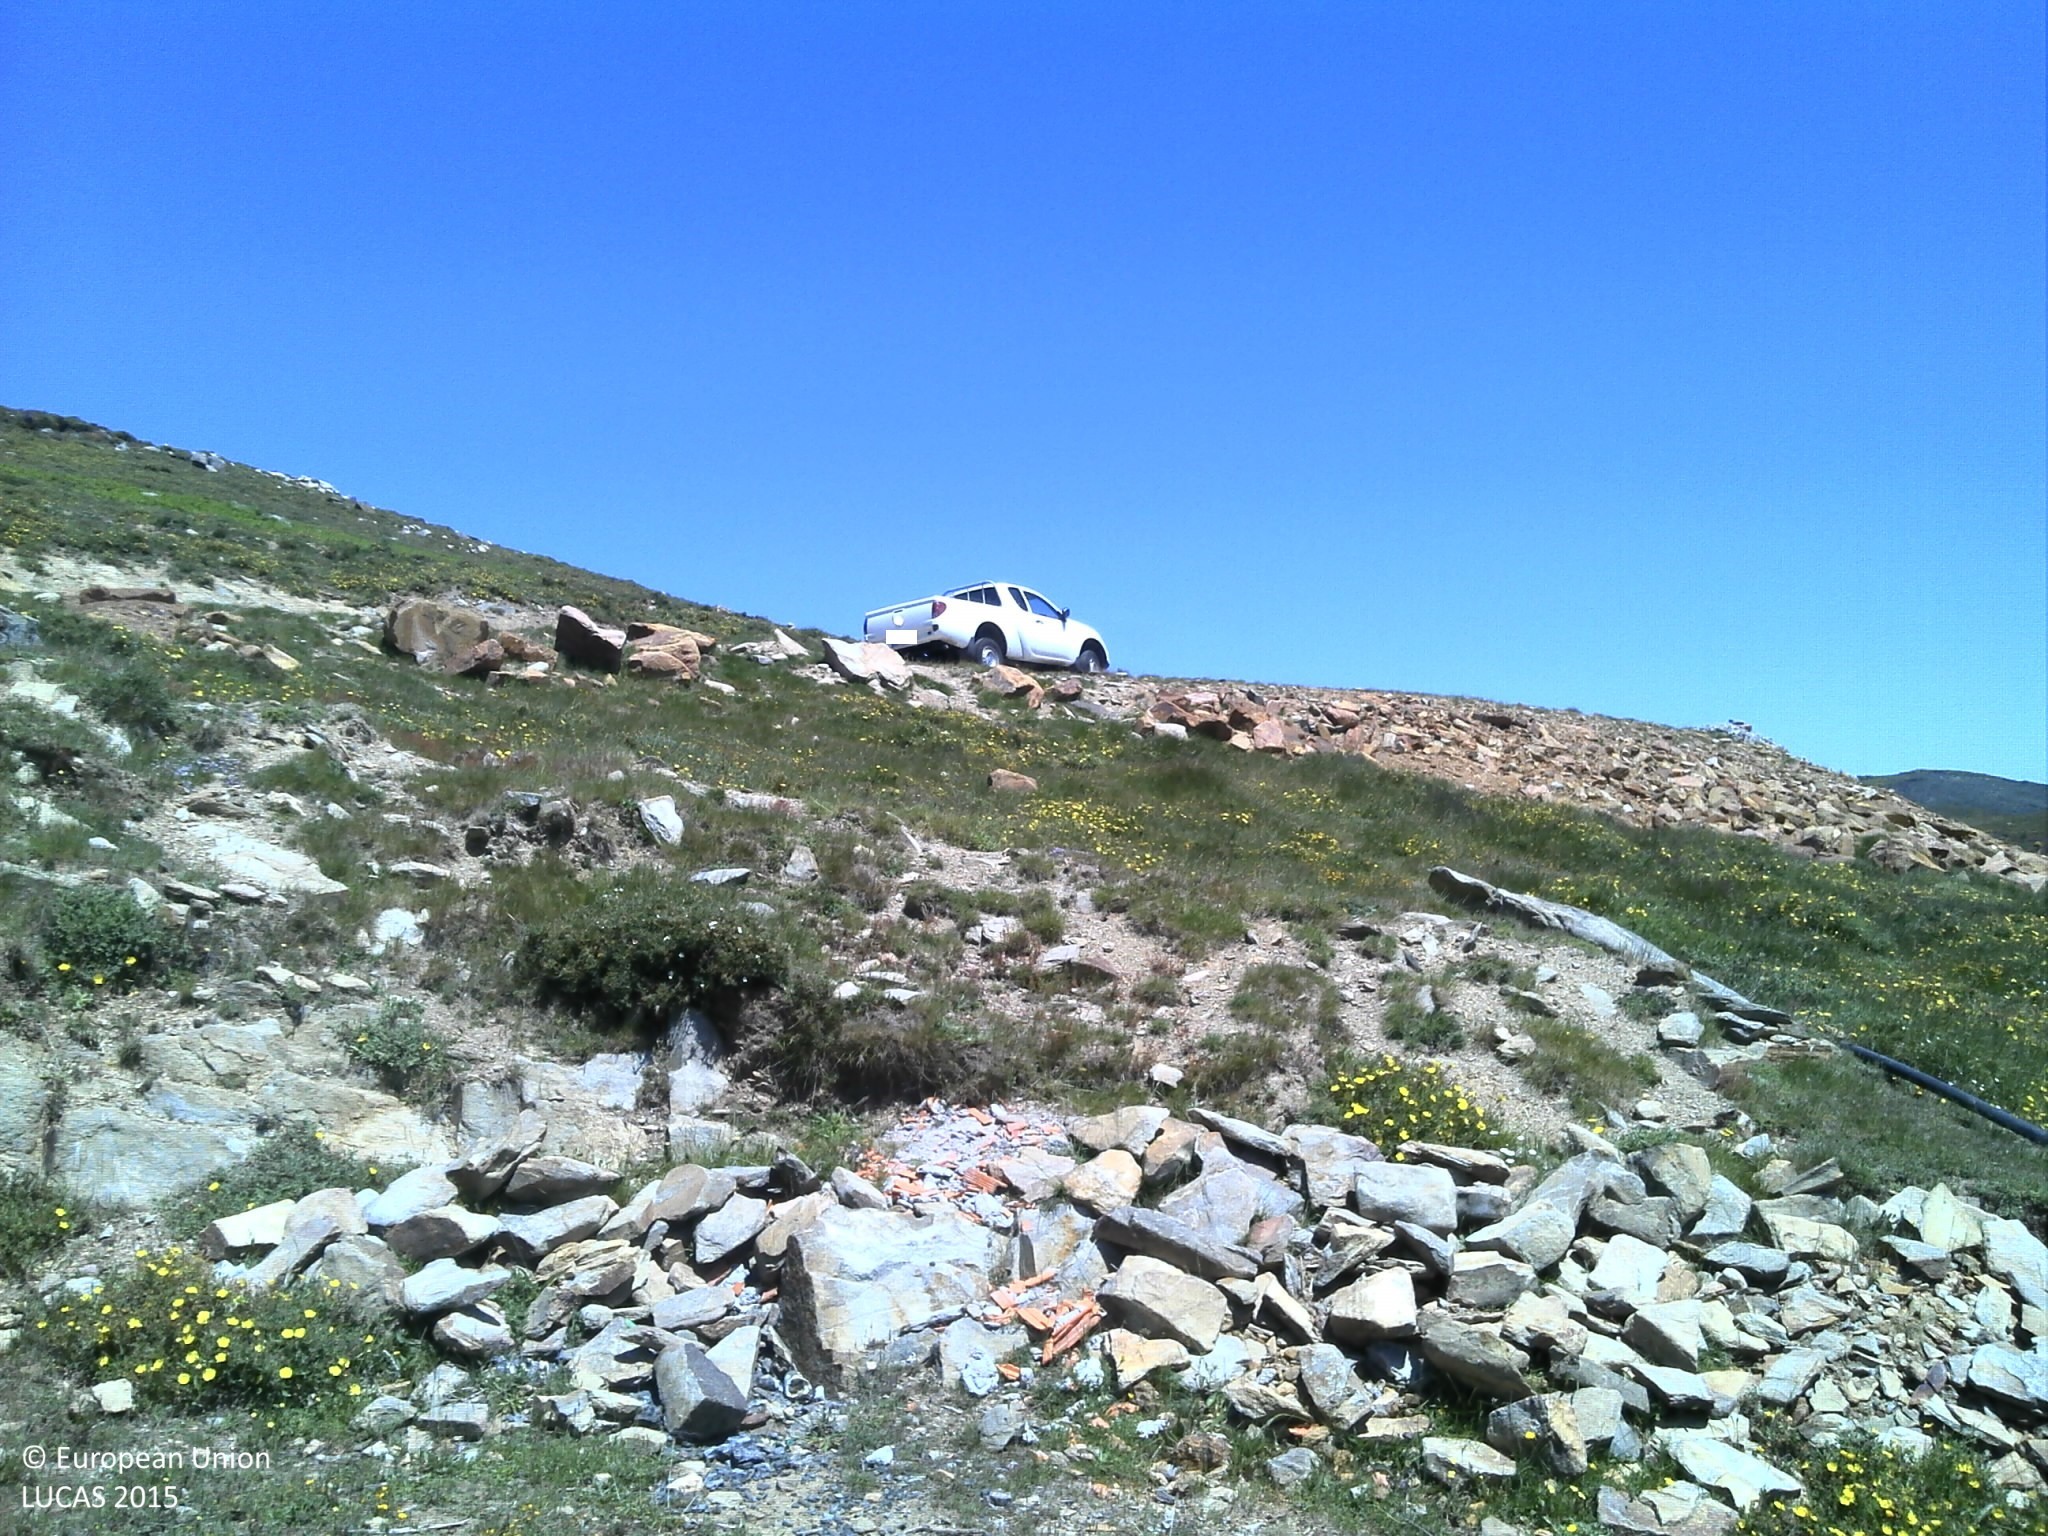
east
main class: Cropland
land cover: Other fresh vegetables
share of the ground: 50 - 75 %
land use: Kitchen garden
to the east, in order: Other fresh vegetables; Abandoned hedges; Vineyards; Artificial constructions; Rocks and stones; Shrubland without tree cover; Rock outcrops; Paved roads, cycling and walking lanes; Rock outcrops; Shrubland without tree cover; Grassland with sparse tree/shrub cover; Shrubland without tree cover
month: May
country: PT
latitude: 40.9455
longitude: -8.0338
